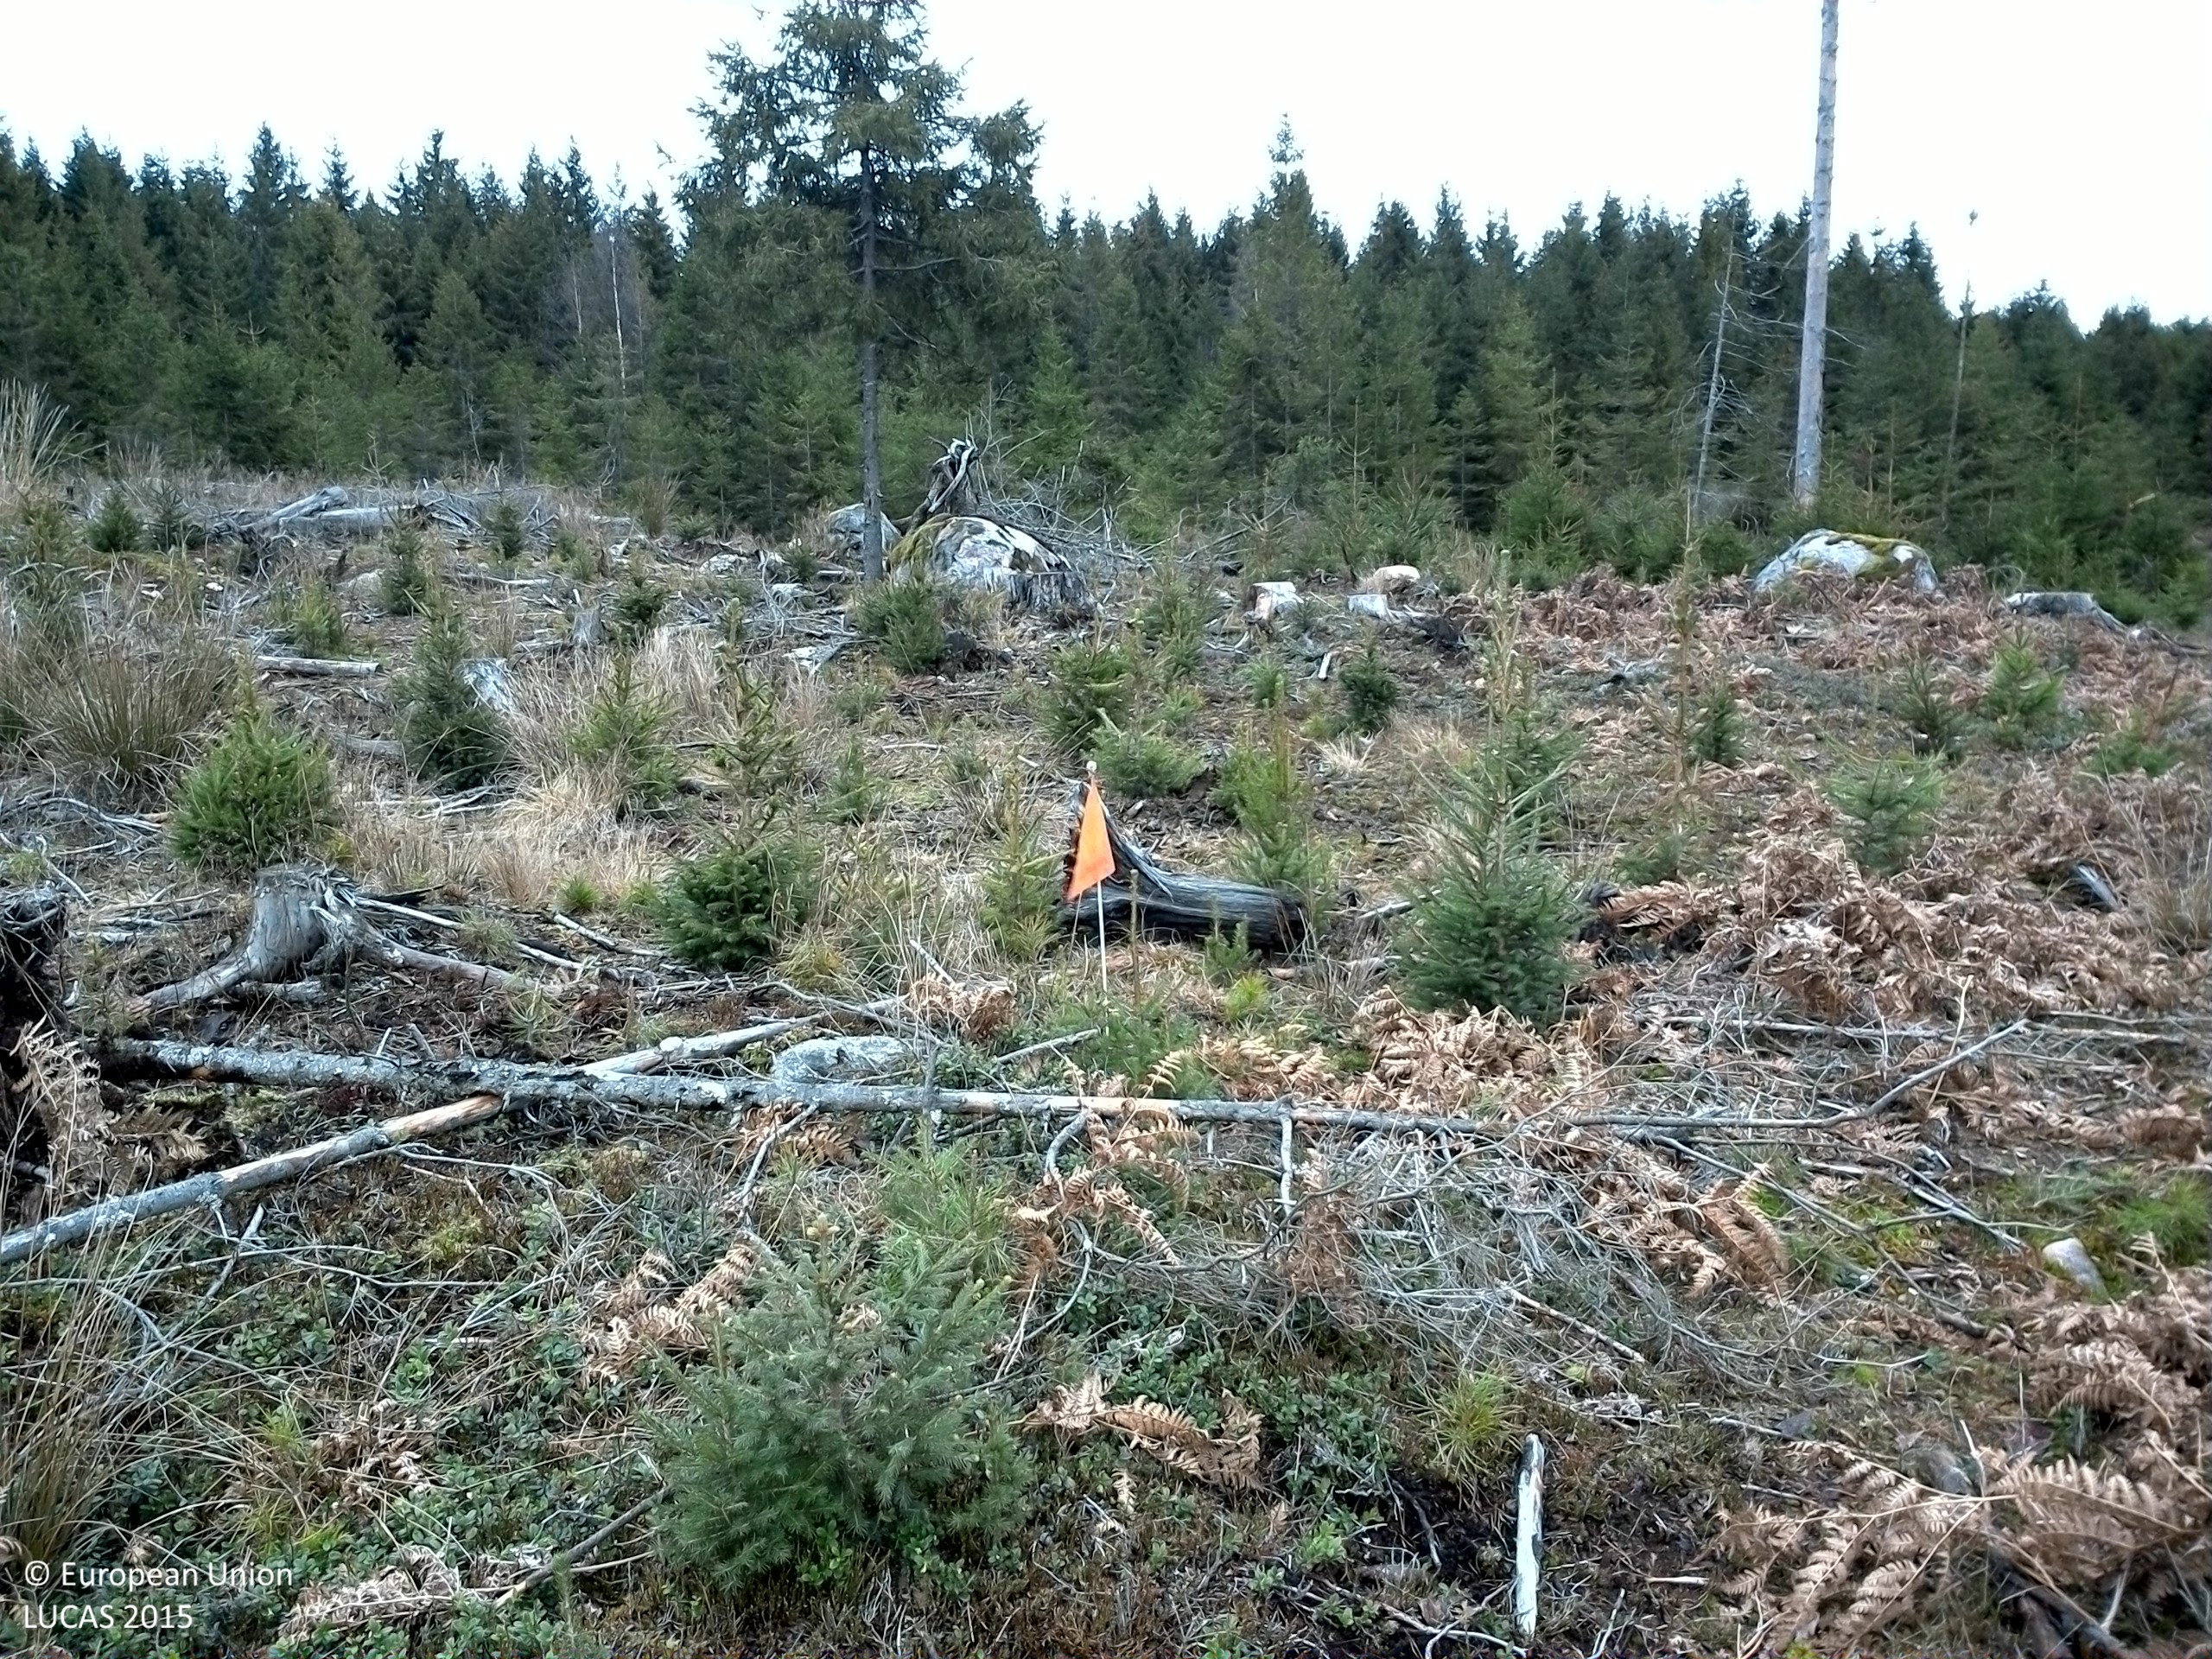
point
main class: Woodland
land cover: Spruce dominated coniferous woodland
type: boreal forest
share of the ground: 10 - 25 %
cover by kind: herbaceous plants 50 %, coniferous forest trees 20 %, shrubs 10 %, lichens and mosses 10 %, unconsolidated bare surface 10 %
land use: Forestry
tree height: < 5 m
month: November
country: SE
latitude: 58.9261
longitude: 16.9265
